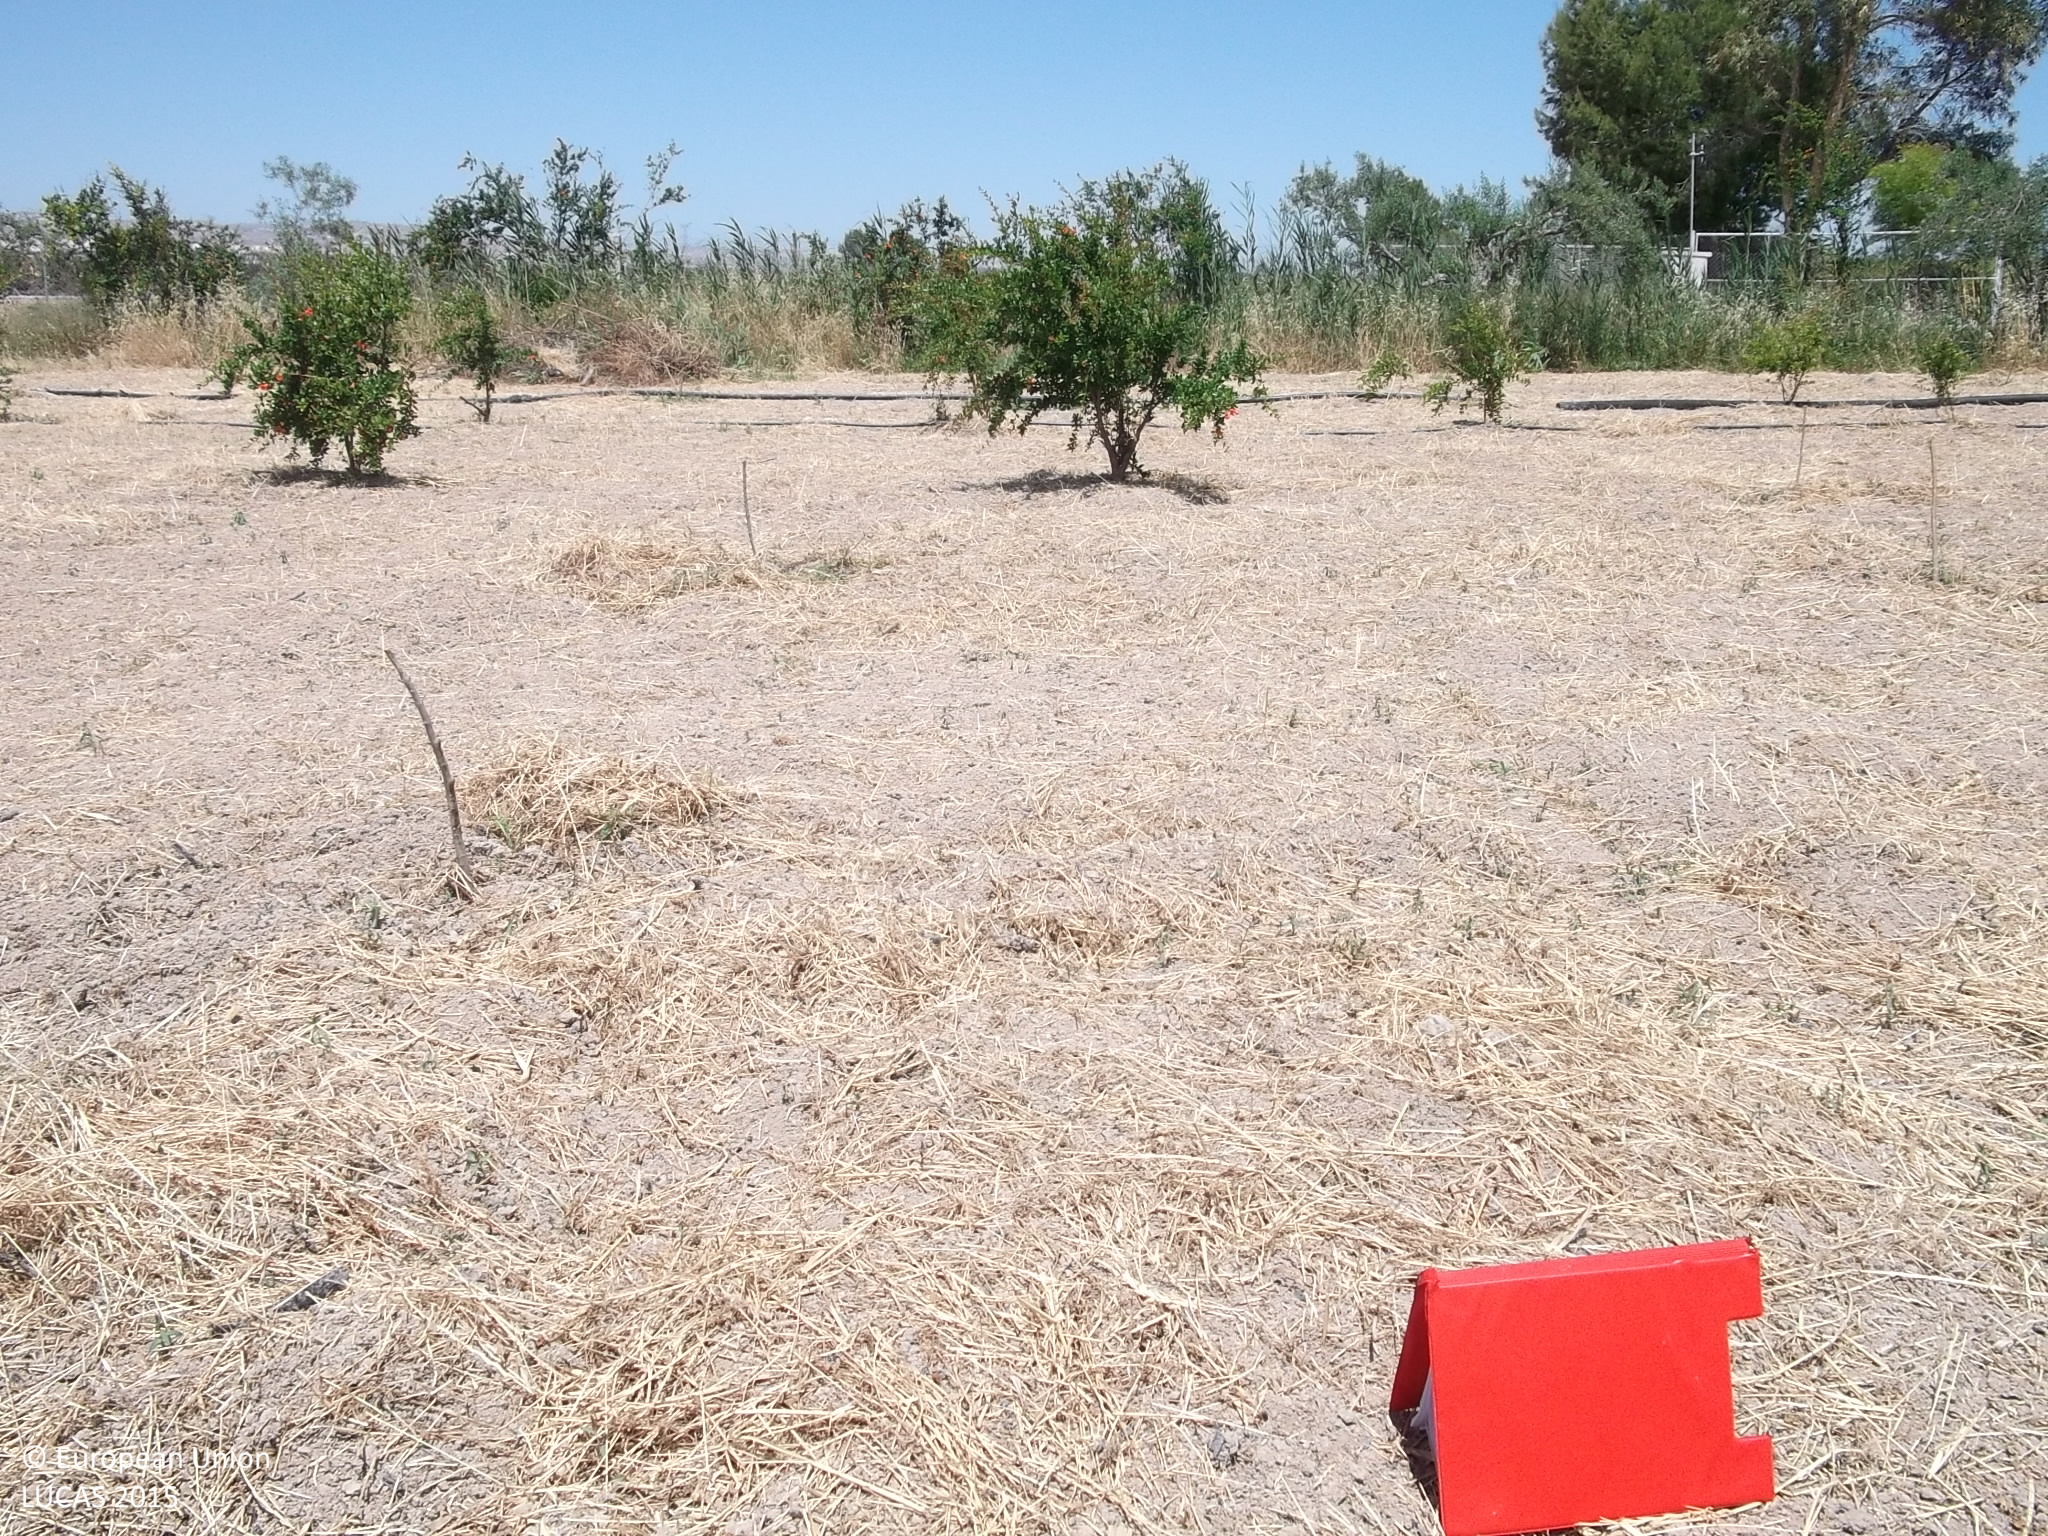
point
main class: Cropland
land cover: Other fruit trees and berries
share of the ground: < 10 %
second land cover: Other bare soil
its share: > 75 %
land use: Agriculture (excluding fallow land and kitchen gardens)
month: May
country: ES
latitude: 38.1859
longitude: -0.8424
